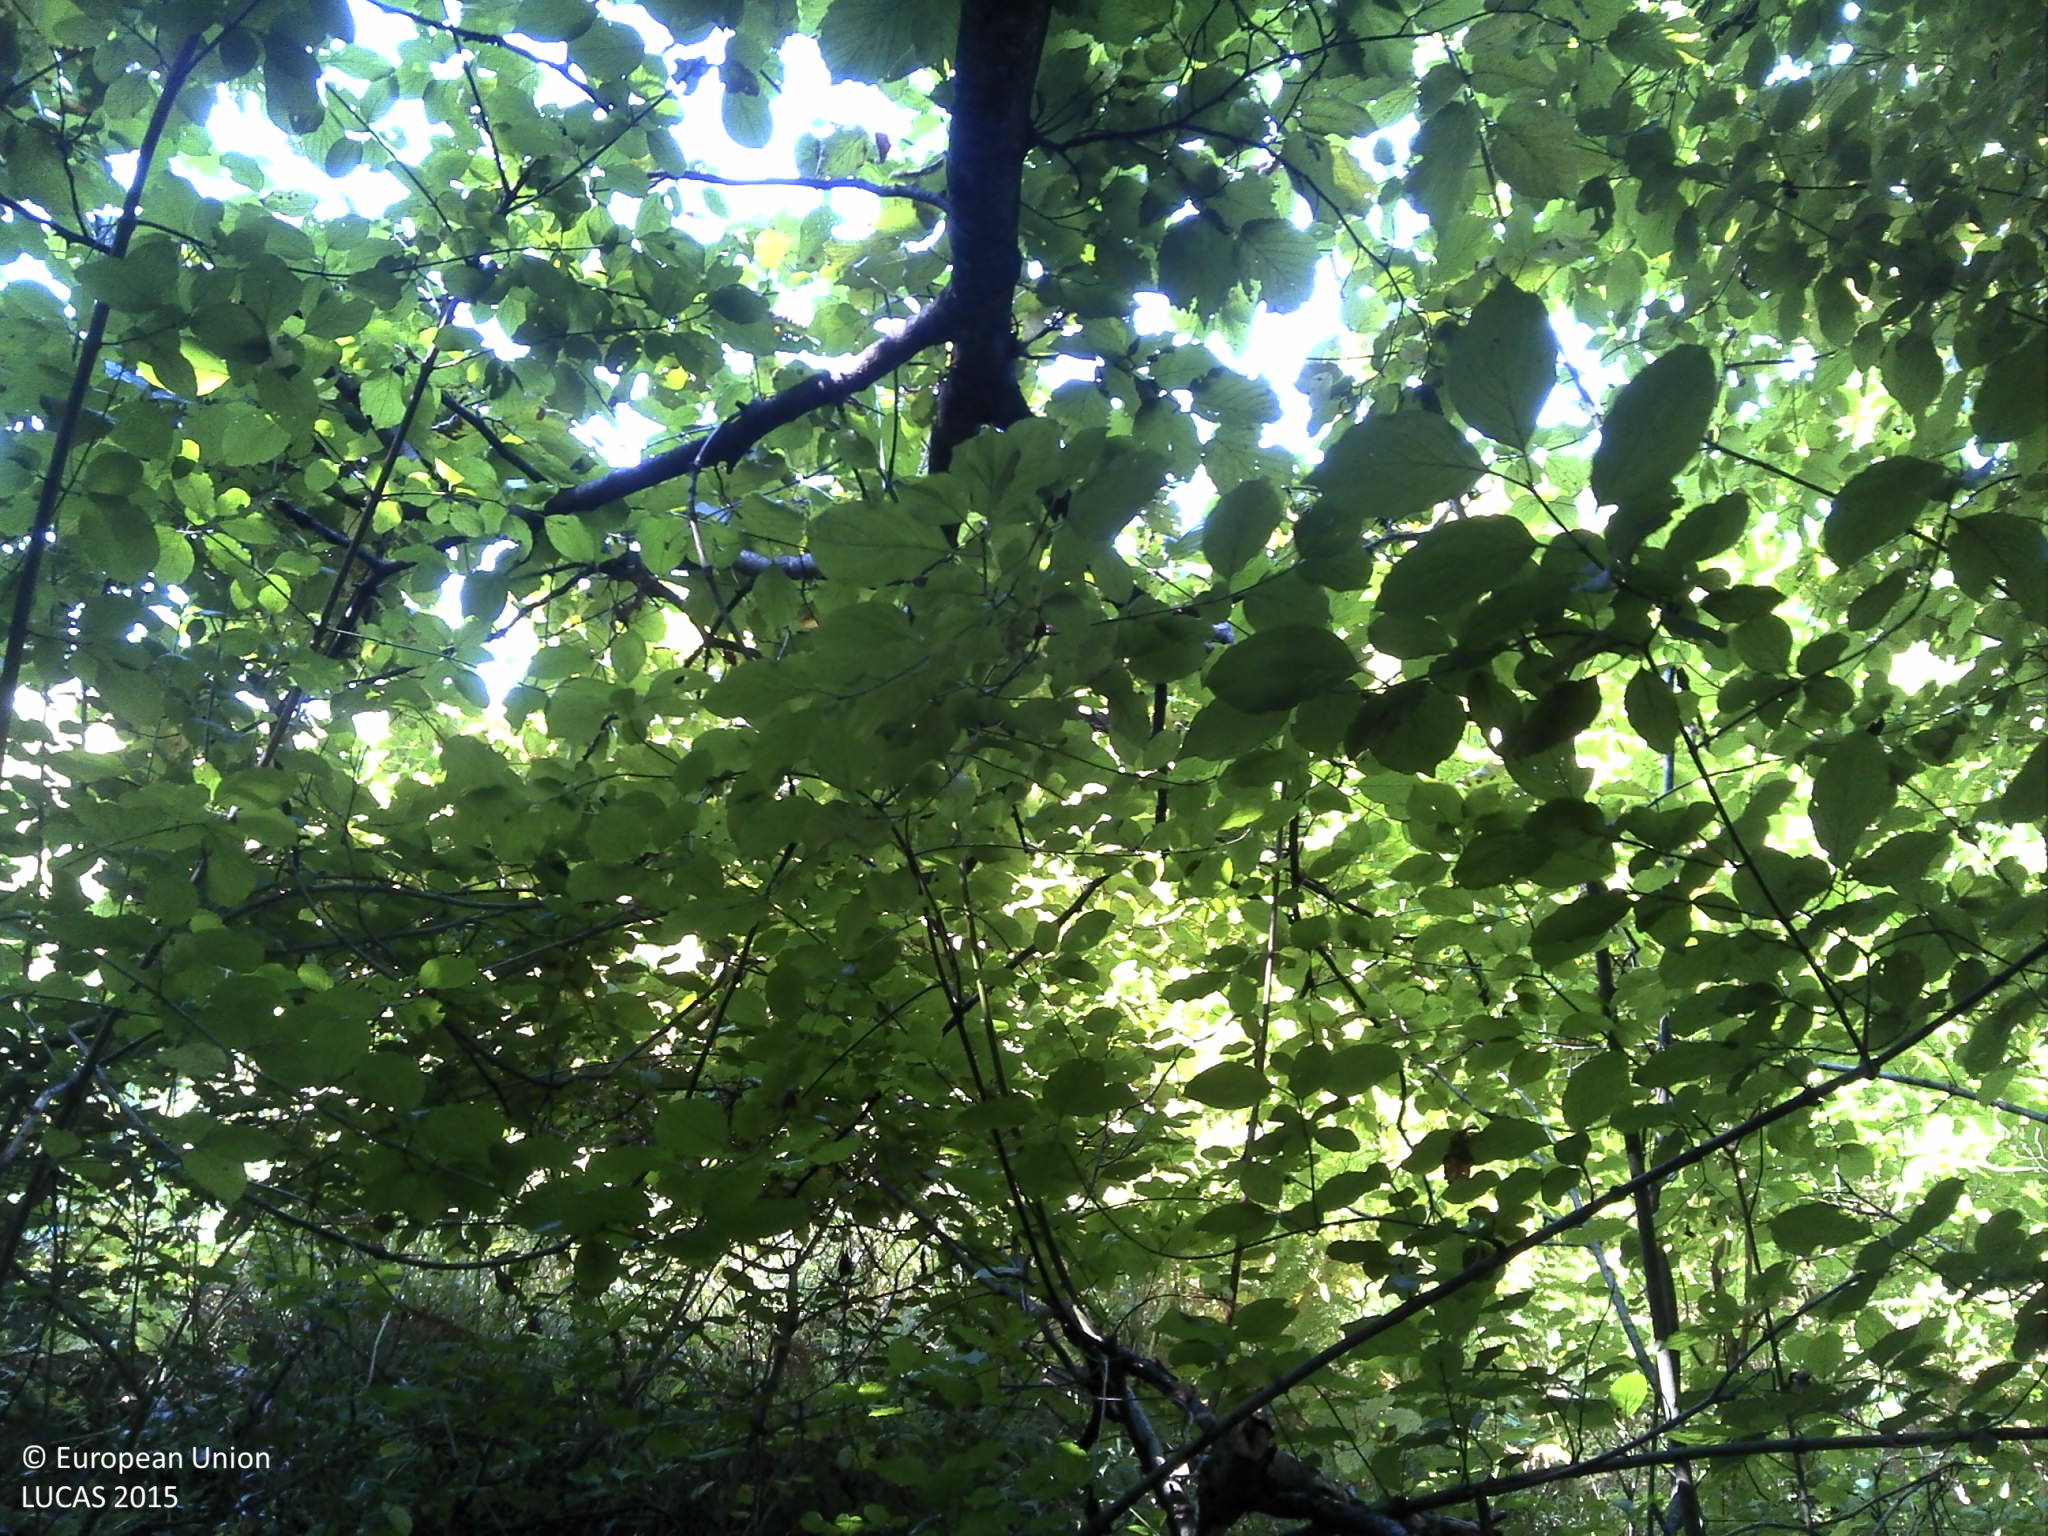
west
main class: Woodland
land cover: Broadleaved woodland
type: mesophytic deciduous forest
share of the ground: > 75 %
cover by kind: broadleaved forest trees 95 %, herbaceous plants 5 %
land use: Forestry
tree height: > 5 m
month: September
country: HR
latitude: 44.9371
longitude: 15.6592
